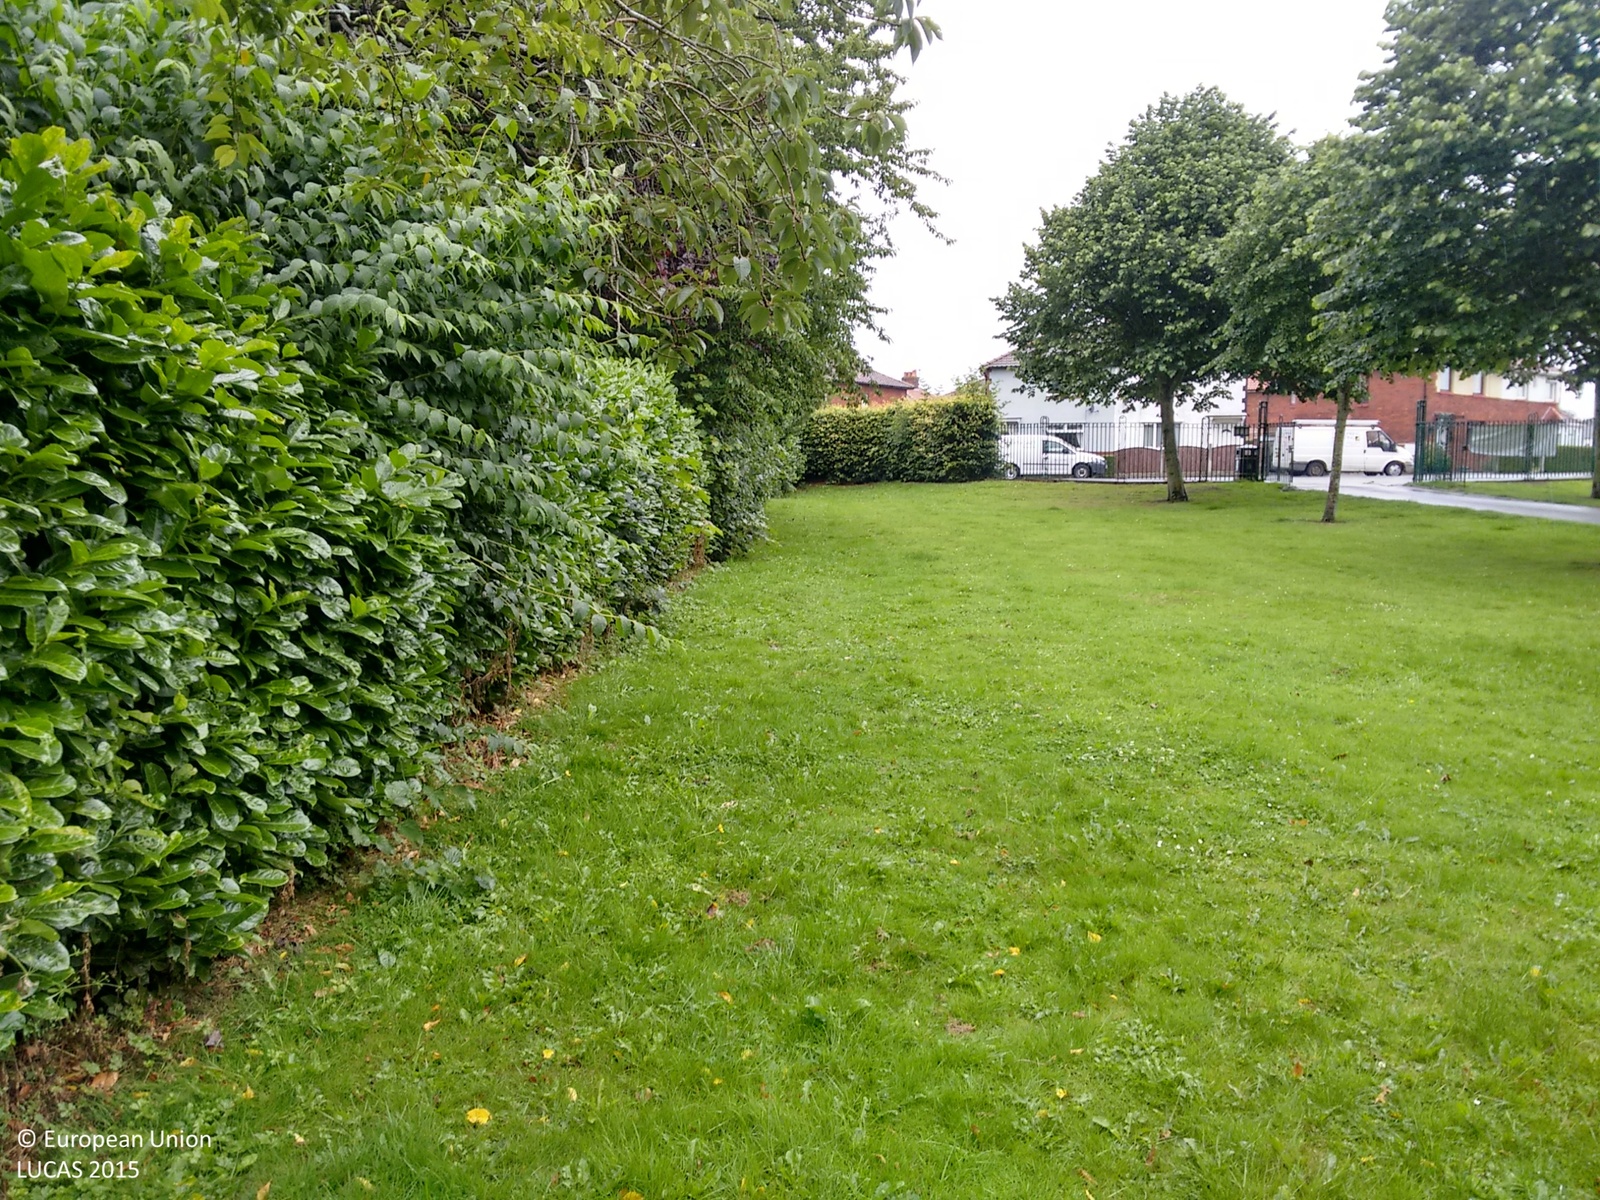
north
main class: Woodland
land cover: Broadleaved woodland
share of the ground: > 75 %
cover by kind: broadleaved forest trees 100 %
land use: Amenities, museums, leisure
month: July
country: GB
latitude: 54.8739
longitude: -2.9271
